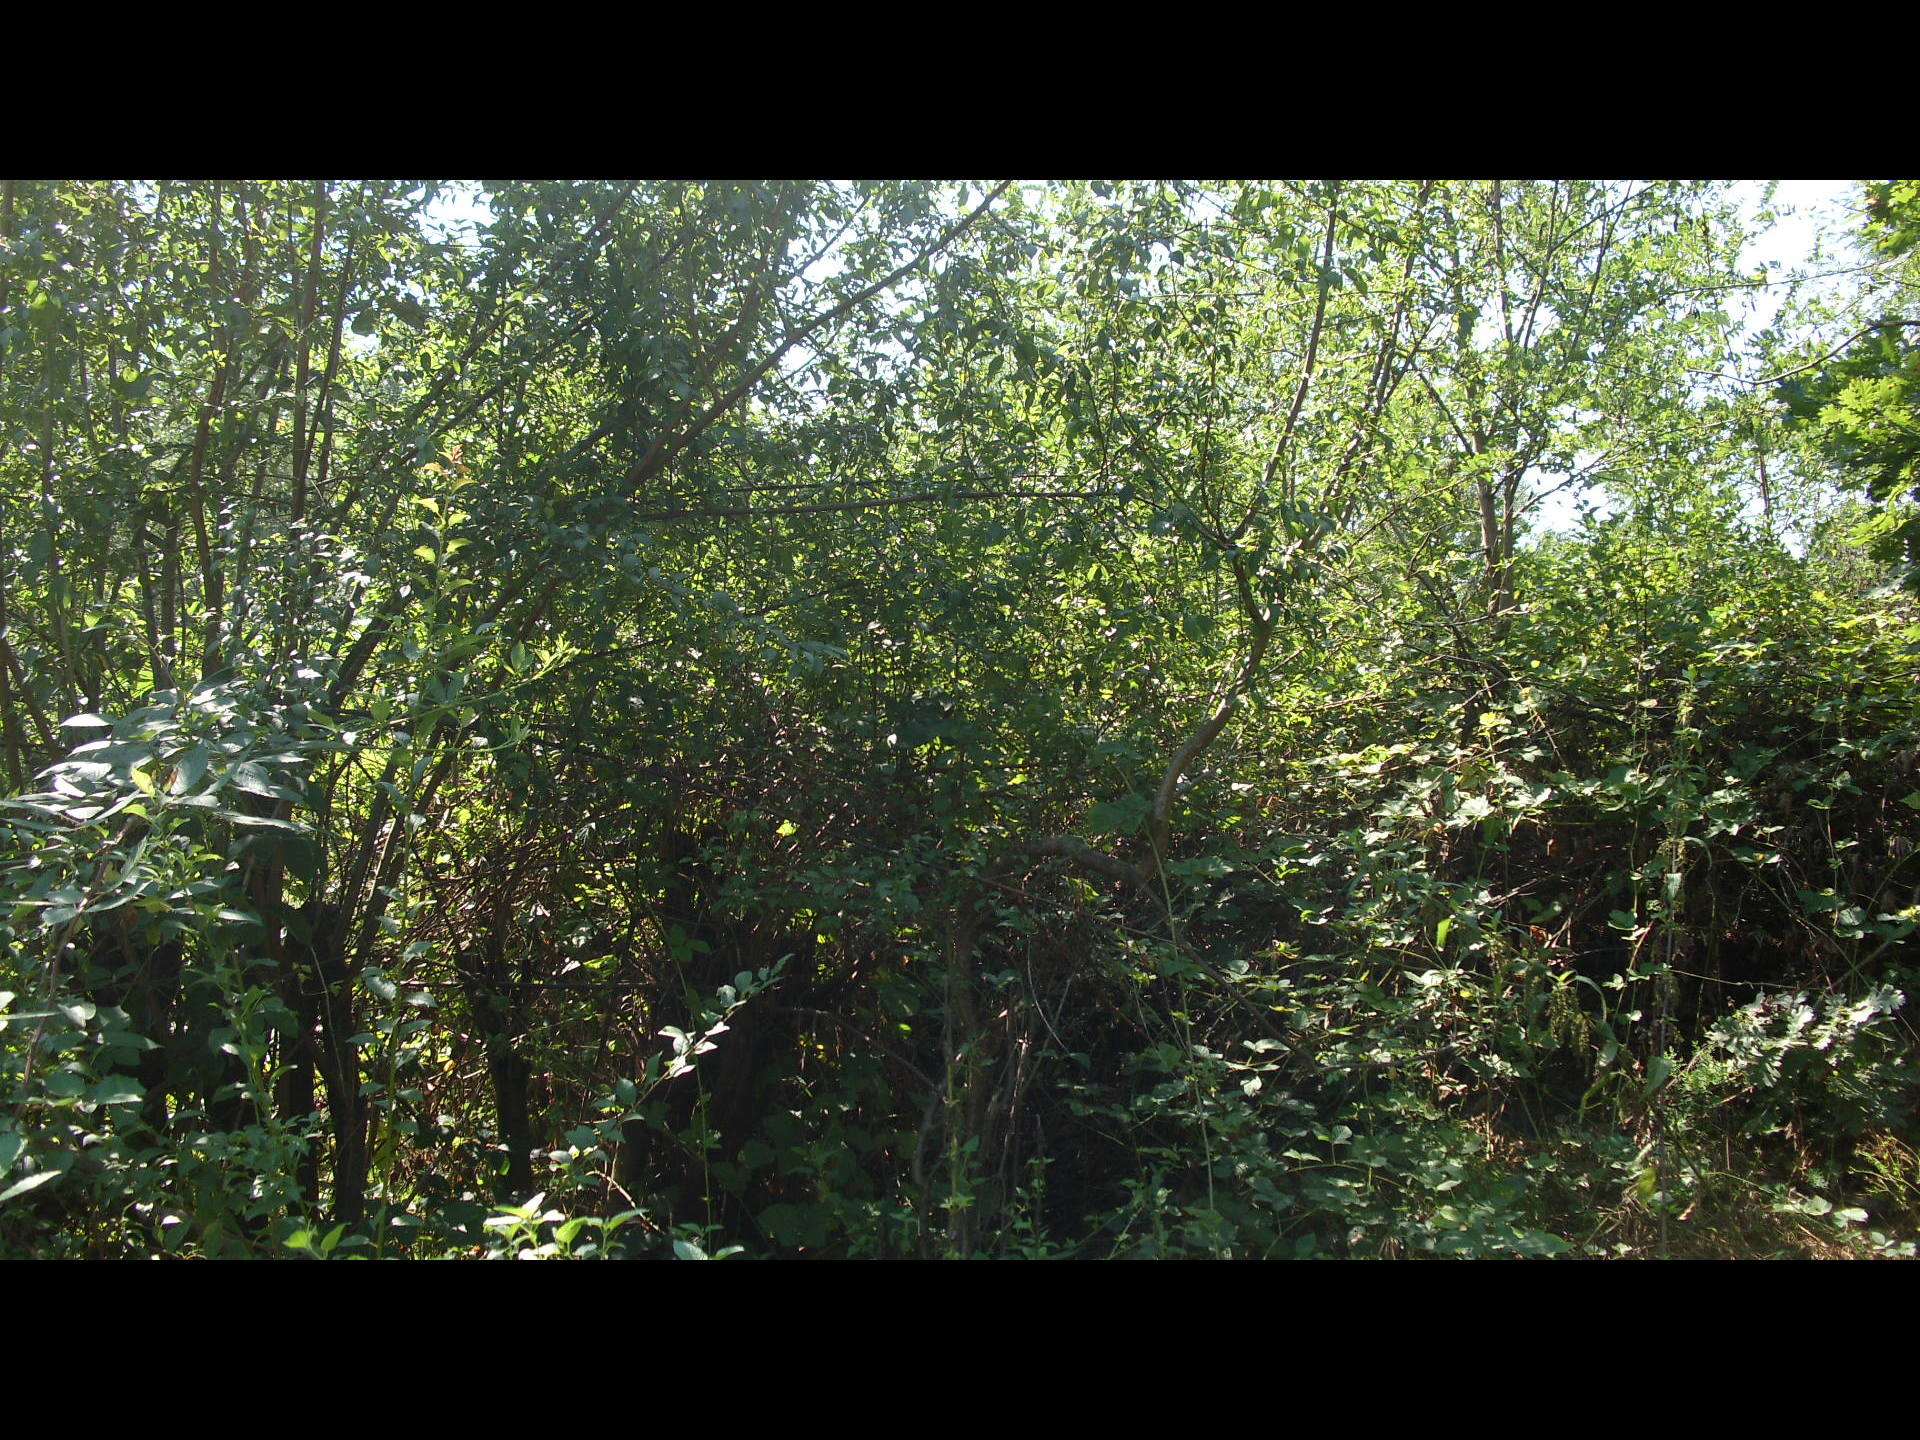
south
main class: Woodland
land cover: Broadleaved woodland
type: thermophilous deciduous forest
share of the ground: 50 - 75 %
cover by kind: broadleaved forest trees 60 %, shrubs 20 %, herbaceous plants 20 %
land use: Forestry
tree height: < 5 m
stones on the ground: < 10 %
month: August
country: BG
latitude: 43.4912
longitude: 23.0088
